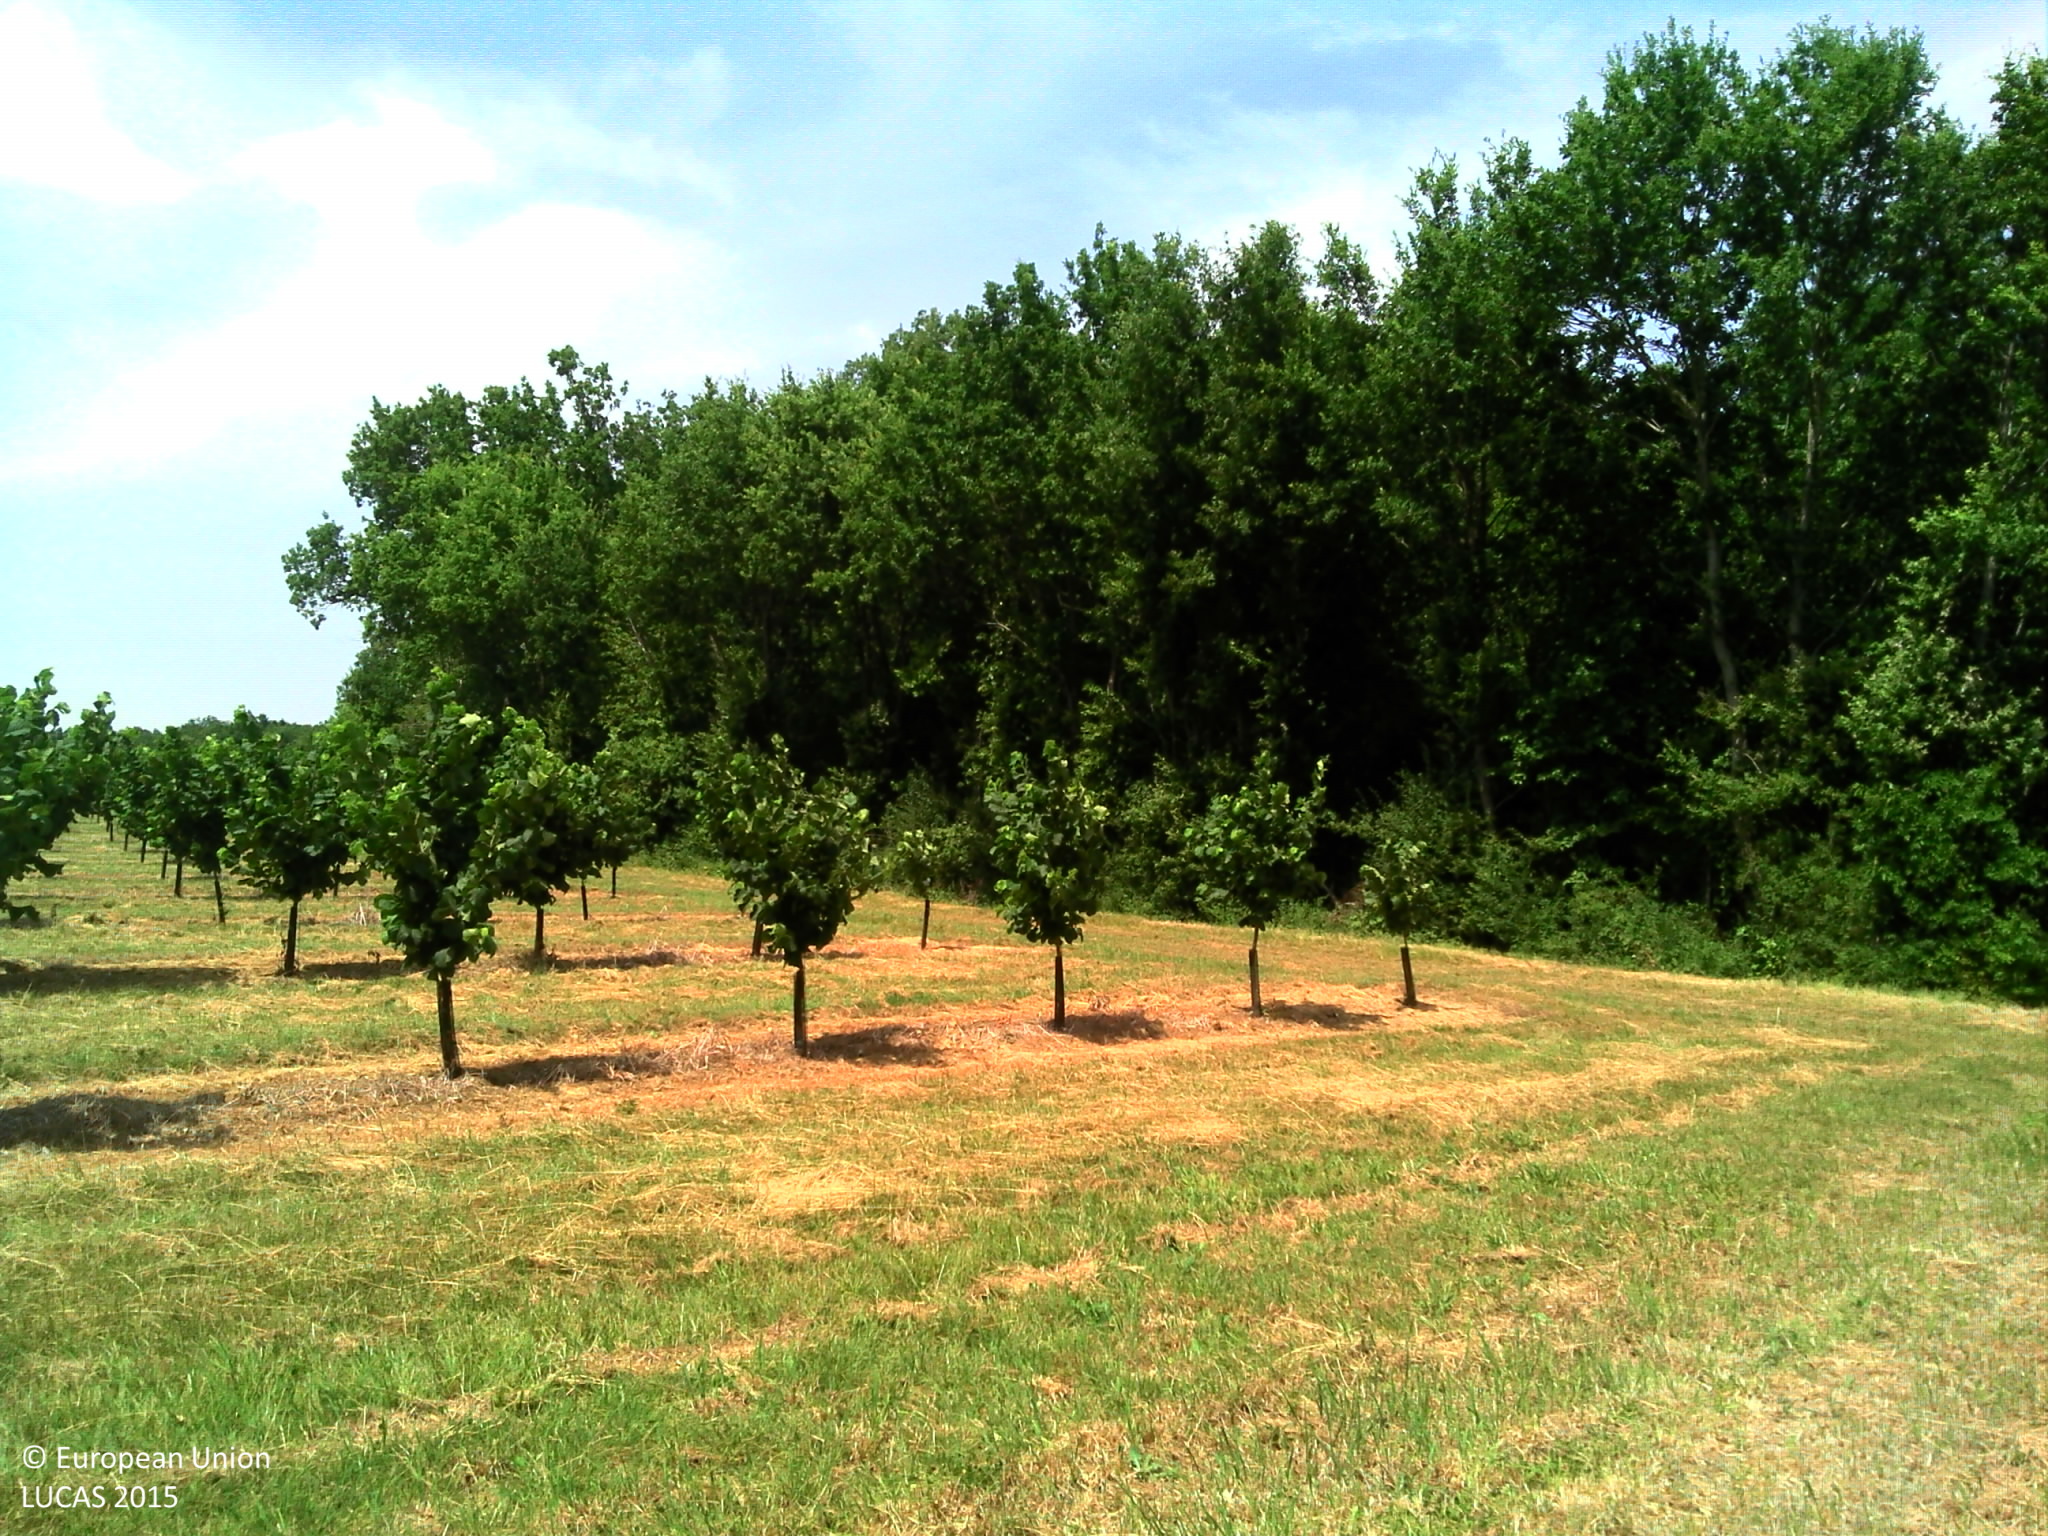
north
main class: Grassland
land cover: Grassland without tree/shrub cover
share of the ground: > 75 %
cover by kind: herbaceous plants 100 %
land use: Agriculture (excluding fallow land and kitchen gardens)
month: July
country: FR
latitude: 44.5079
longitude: 0.8498
